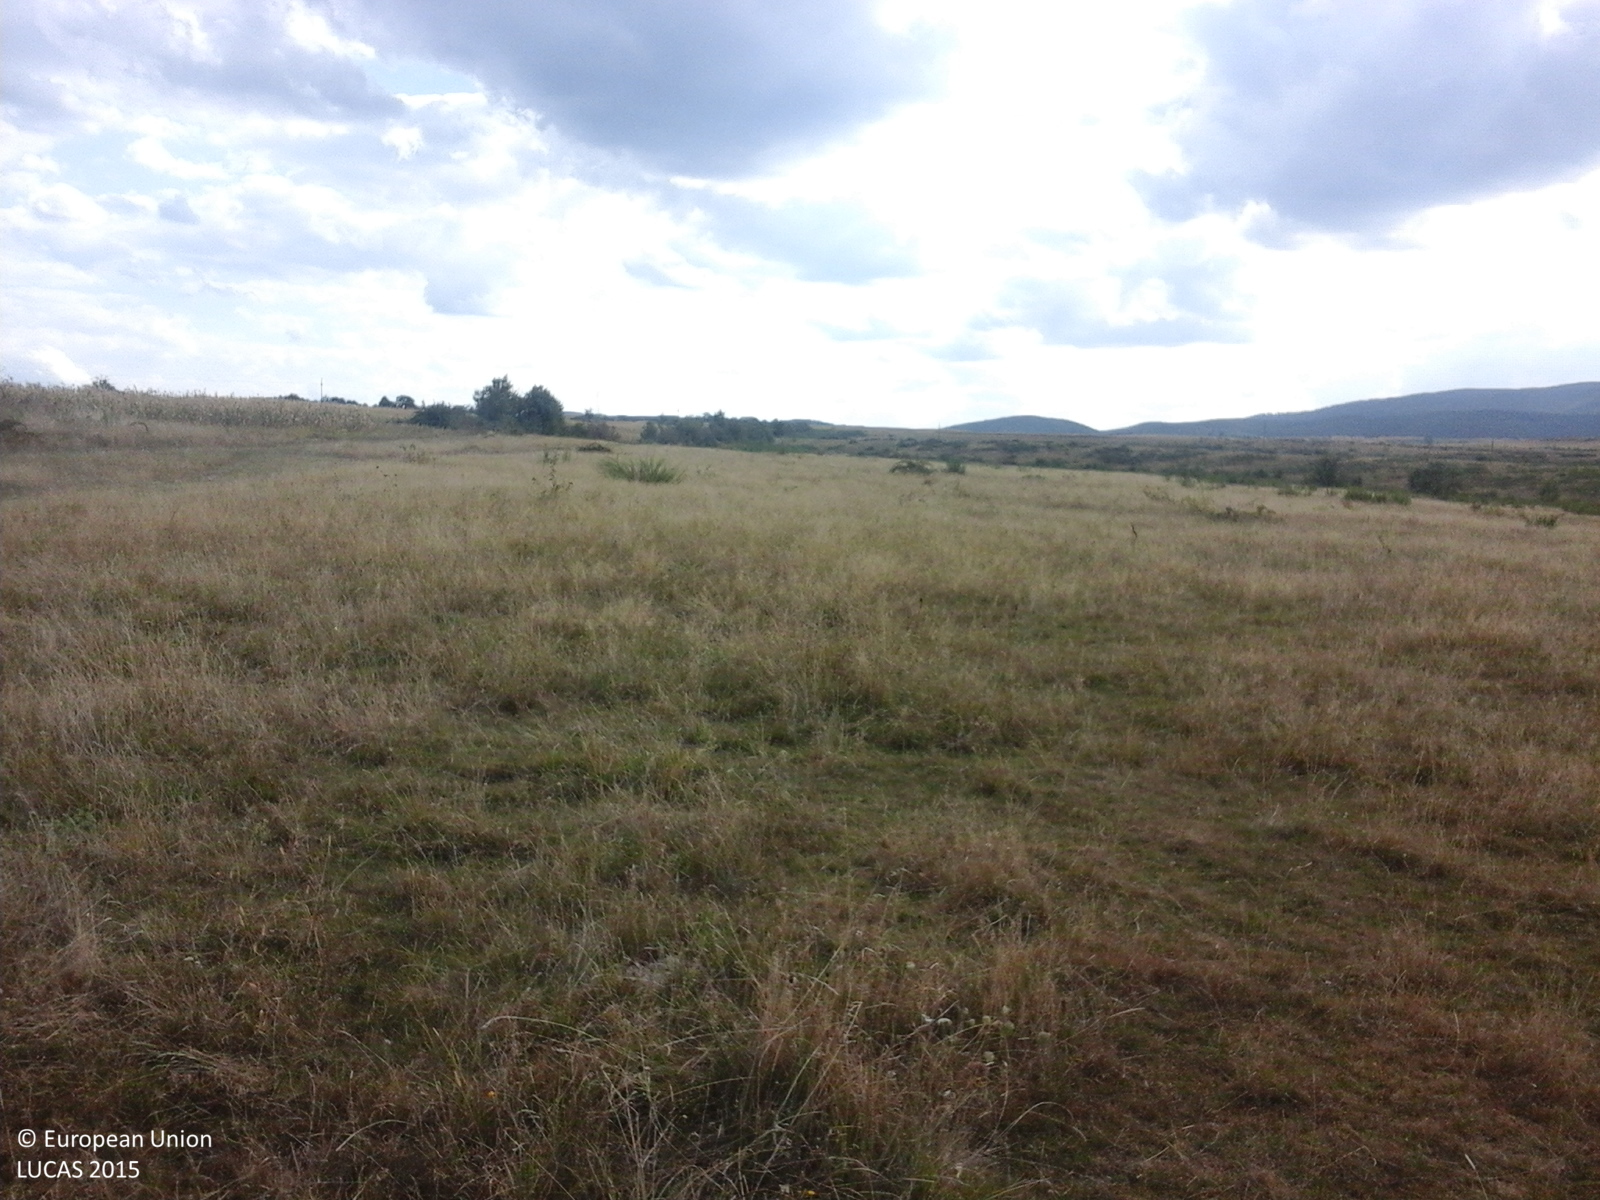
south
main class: Grassland
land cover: Grassland without tree/shrub cover
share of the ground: > 75 %
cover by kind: herbaceous plants 100 %
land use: Agriculture (excluding fallow land and kitchen gardens)
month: September
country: RO
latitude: 47.4874
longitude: 23.4376
